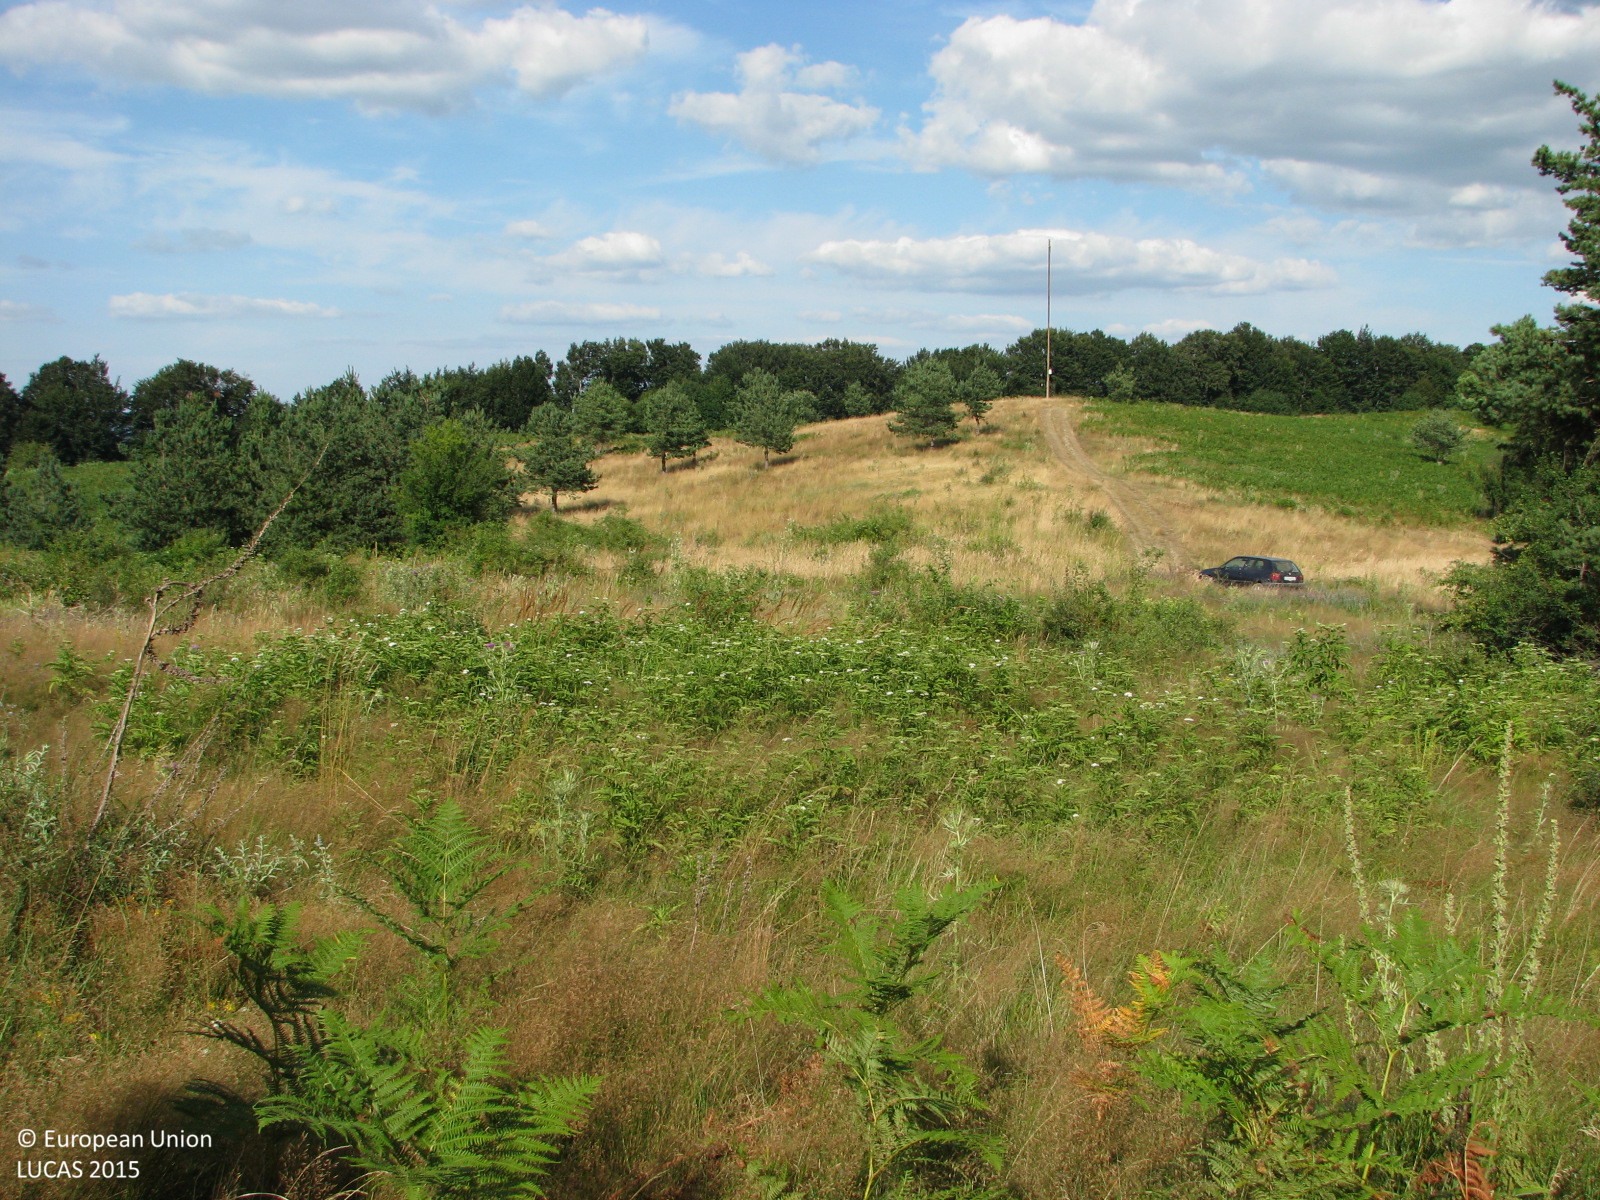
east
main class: Shrubland
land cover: Shrubland with sparse tree cover
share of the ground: > 75 %
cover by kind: shrubs 75 %, herbaceous plants 20 %, coniferous forest trees 5 %
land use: Semi-natural and natural areas not in use
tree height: > 5 m
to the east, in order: Shrubland with sparse tree cover; Pine dominated coniferous woodland; Grassland without tree/shrub cover; Tracks; Grassland with sparse tree/shrub cover; Tracks; Shrubland without tree cover
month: August
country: BG
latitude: 42.8032
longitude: 26.2430
